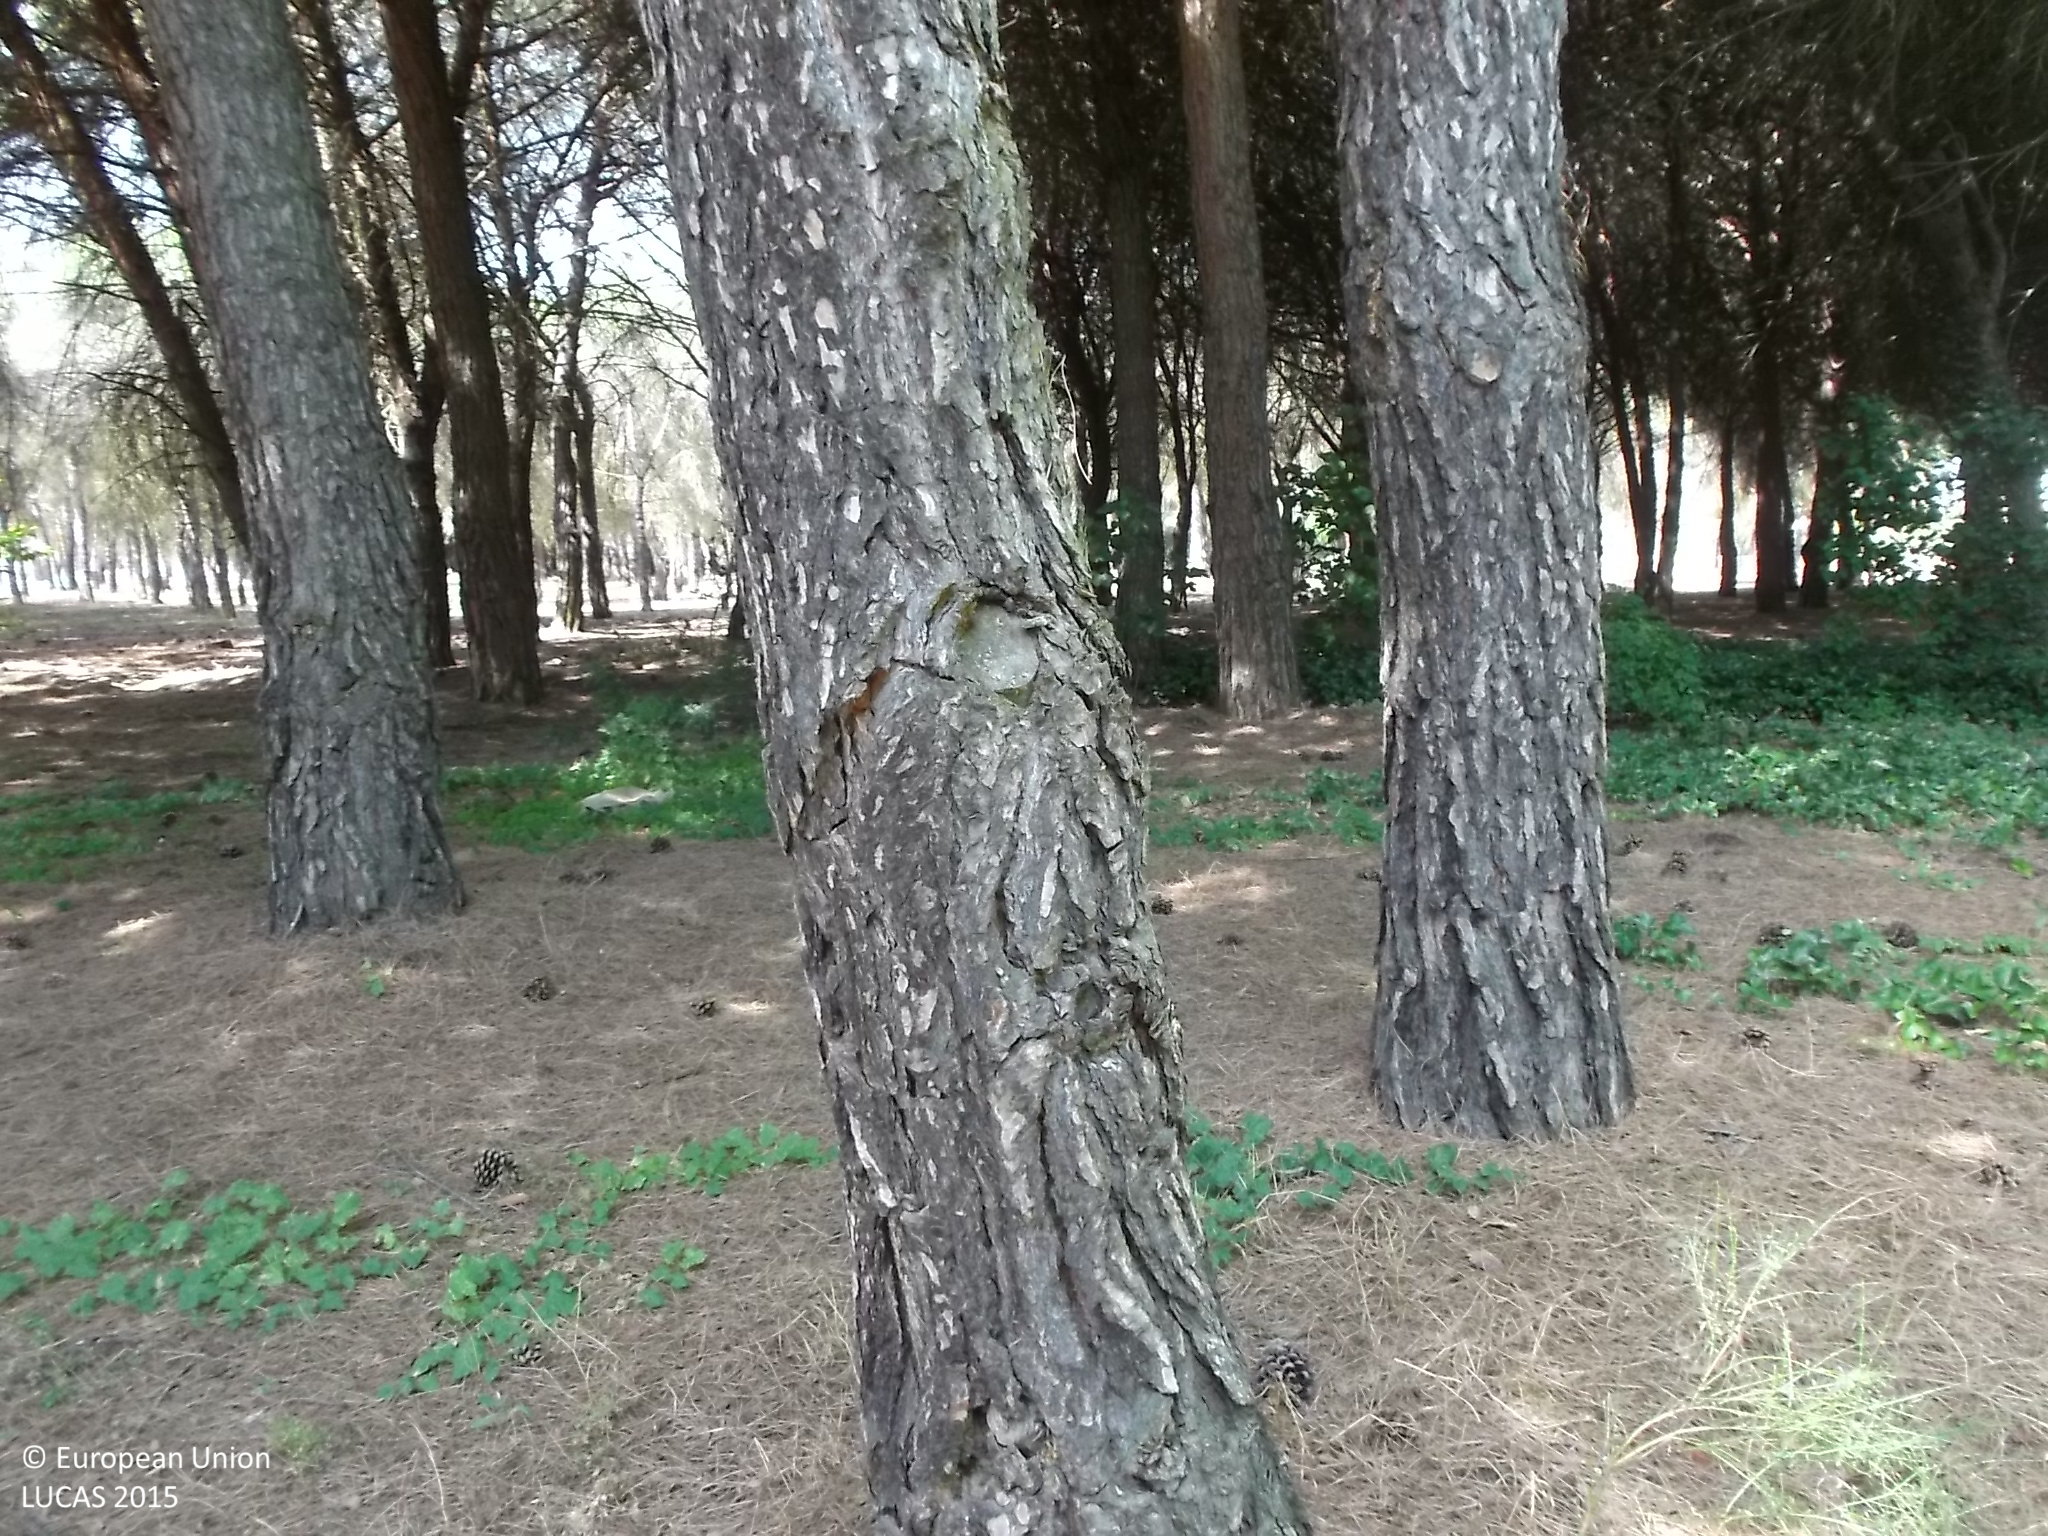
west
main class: Woodland
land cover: Broadleaved woodland
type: broadleaved evergreen forest
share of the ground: > 75 %
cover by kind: broadleaved forest trees 80 %, herbaceous plants 20 %
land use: Residential
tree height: < 5 m
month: July
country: ES
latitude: 41.4904
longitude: -5.3745
